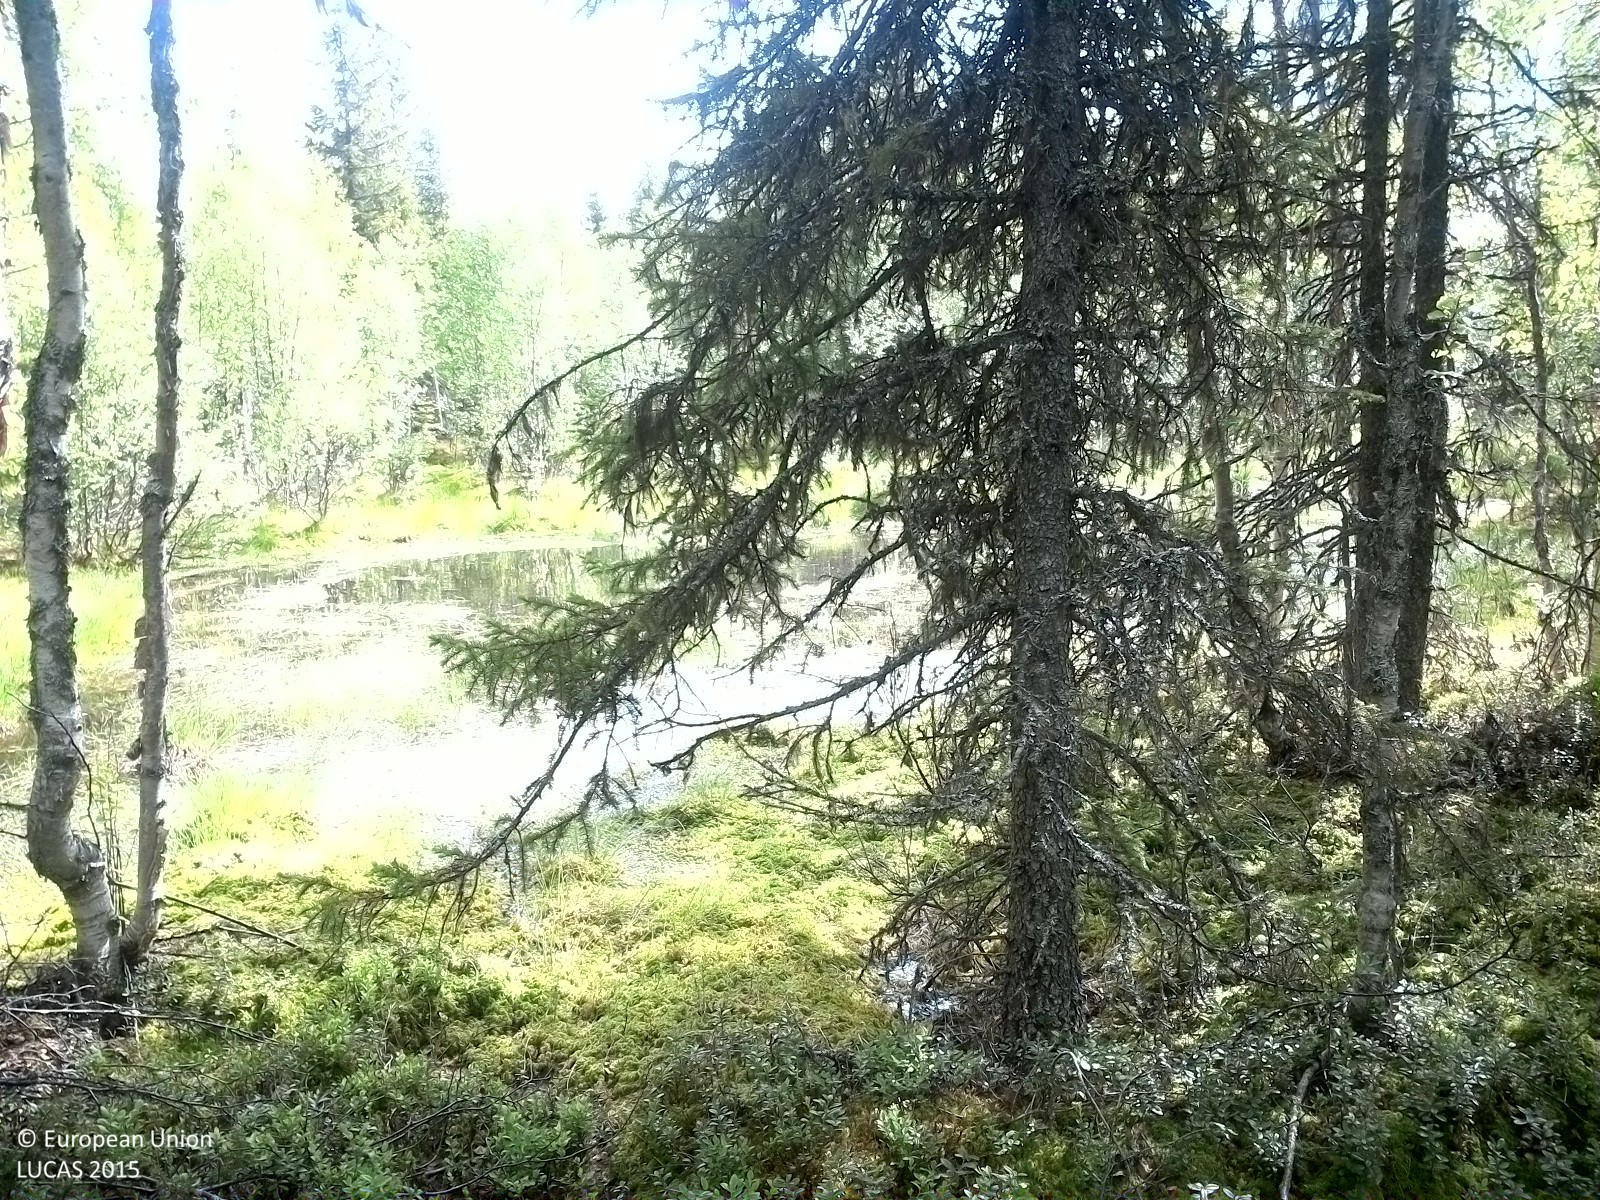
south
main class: Woodland
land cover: Spruce dominated mixed woodland
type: boreal forest
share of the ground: > 75 %
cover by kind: coniferous forest trees 65 %, broadleaved forest trees 25 %, shrubs 10 %
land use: Forestry
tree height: > 5 m
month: June
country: SE
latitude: 63.5314
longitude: 15.3046
